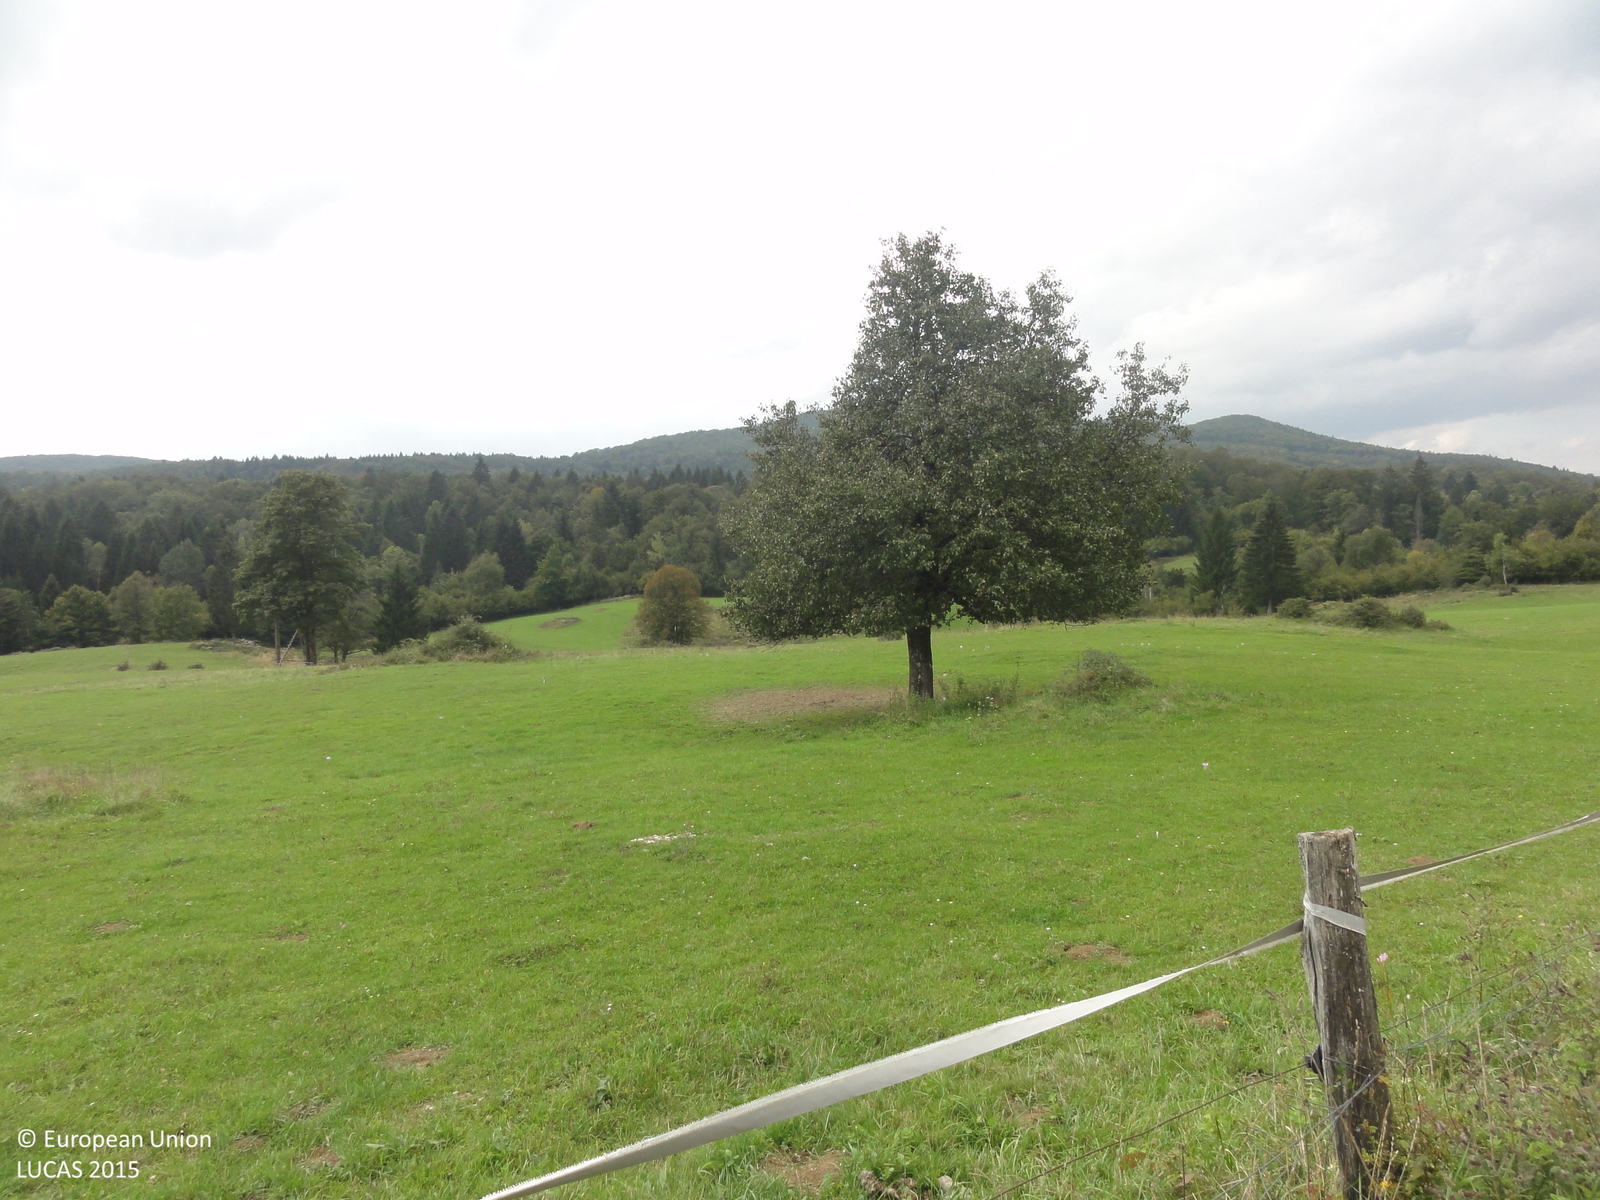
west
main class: Grassland
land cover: Grassland without tree/shrub cover
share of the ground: > 75 %
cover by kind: herbaceous plants 100 %
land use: Agriculture (excluding fallow land and kitchen gardens)
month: September
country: SI
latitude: 45.5303
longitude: 15.0023
